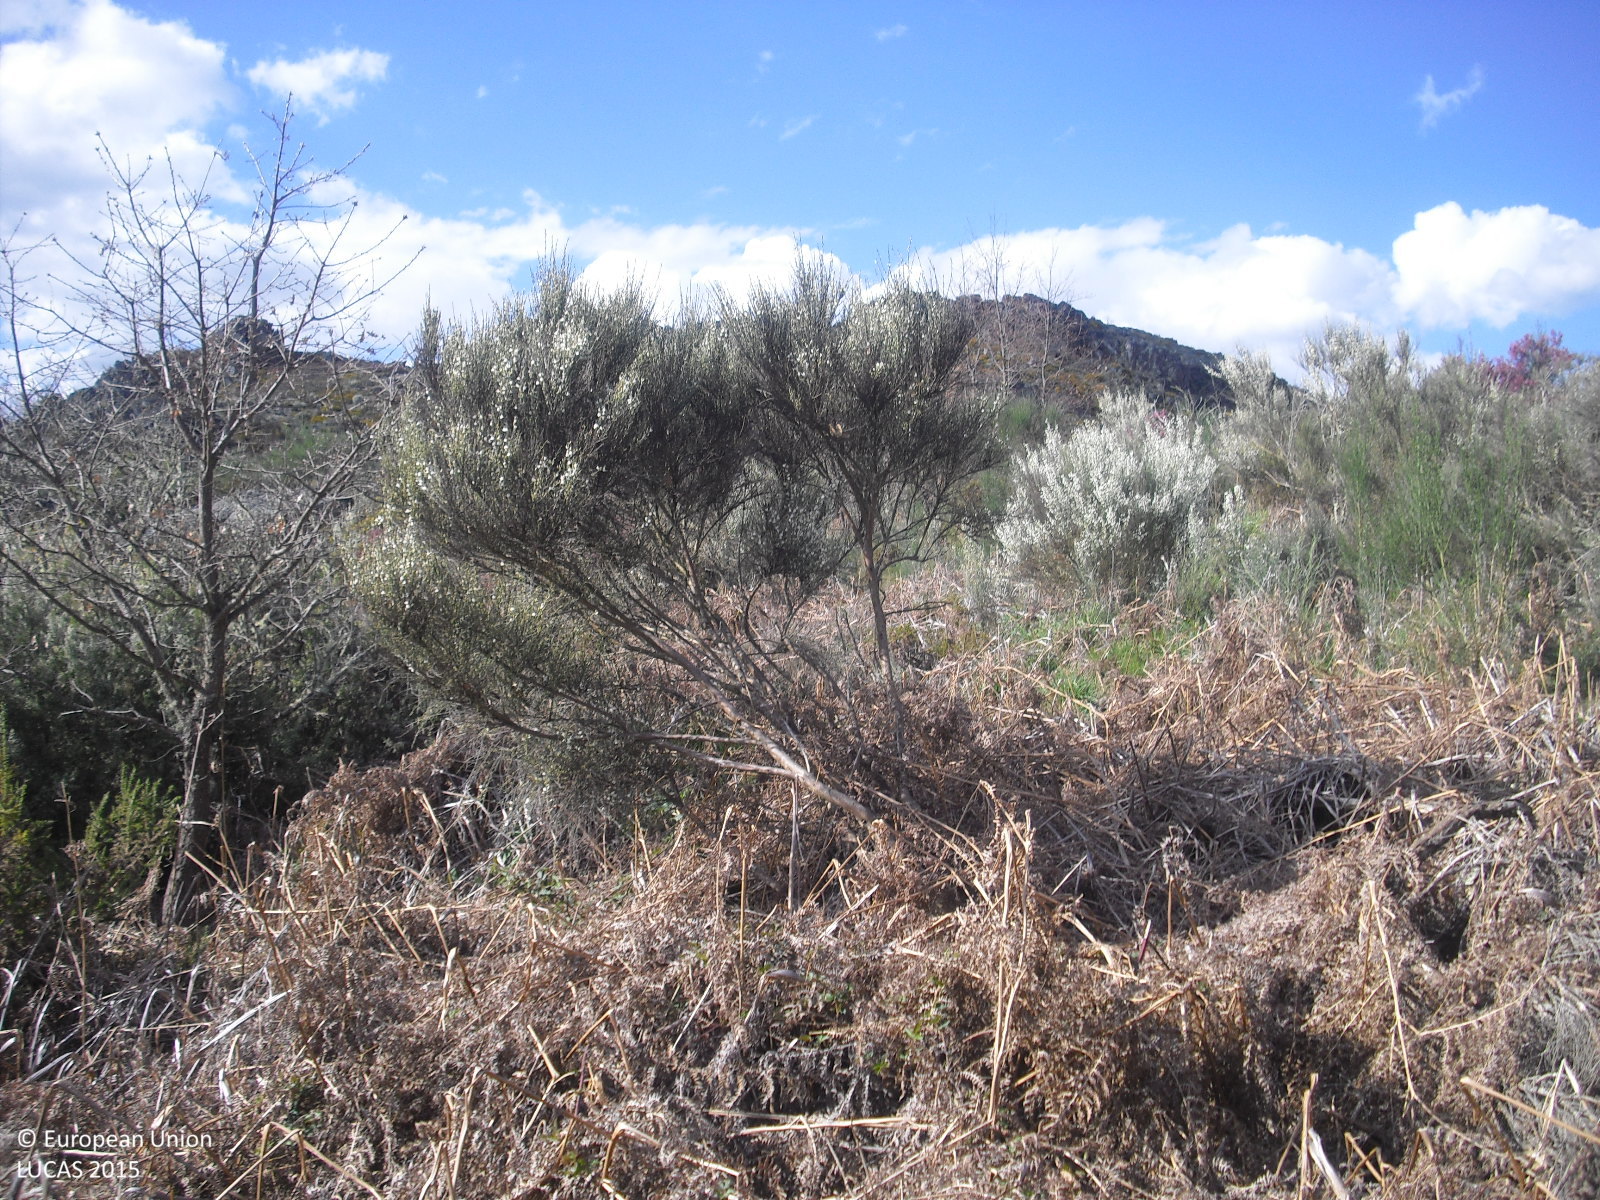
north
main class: Woodland
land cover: Broadleaved woodland
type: acidophilous oak and oak-birch forest
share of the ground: 25 - 50 %
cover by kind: shrubs 50 %, broadleaved forest trees 40 %, herbaceous plants 10 %
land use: Semi-natural and natural areas not in use
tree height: > 5 m
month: April
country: ES
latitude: 41.9193
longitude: -7.8559
